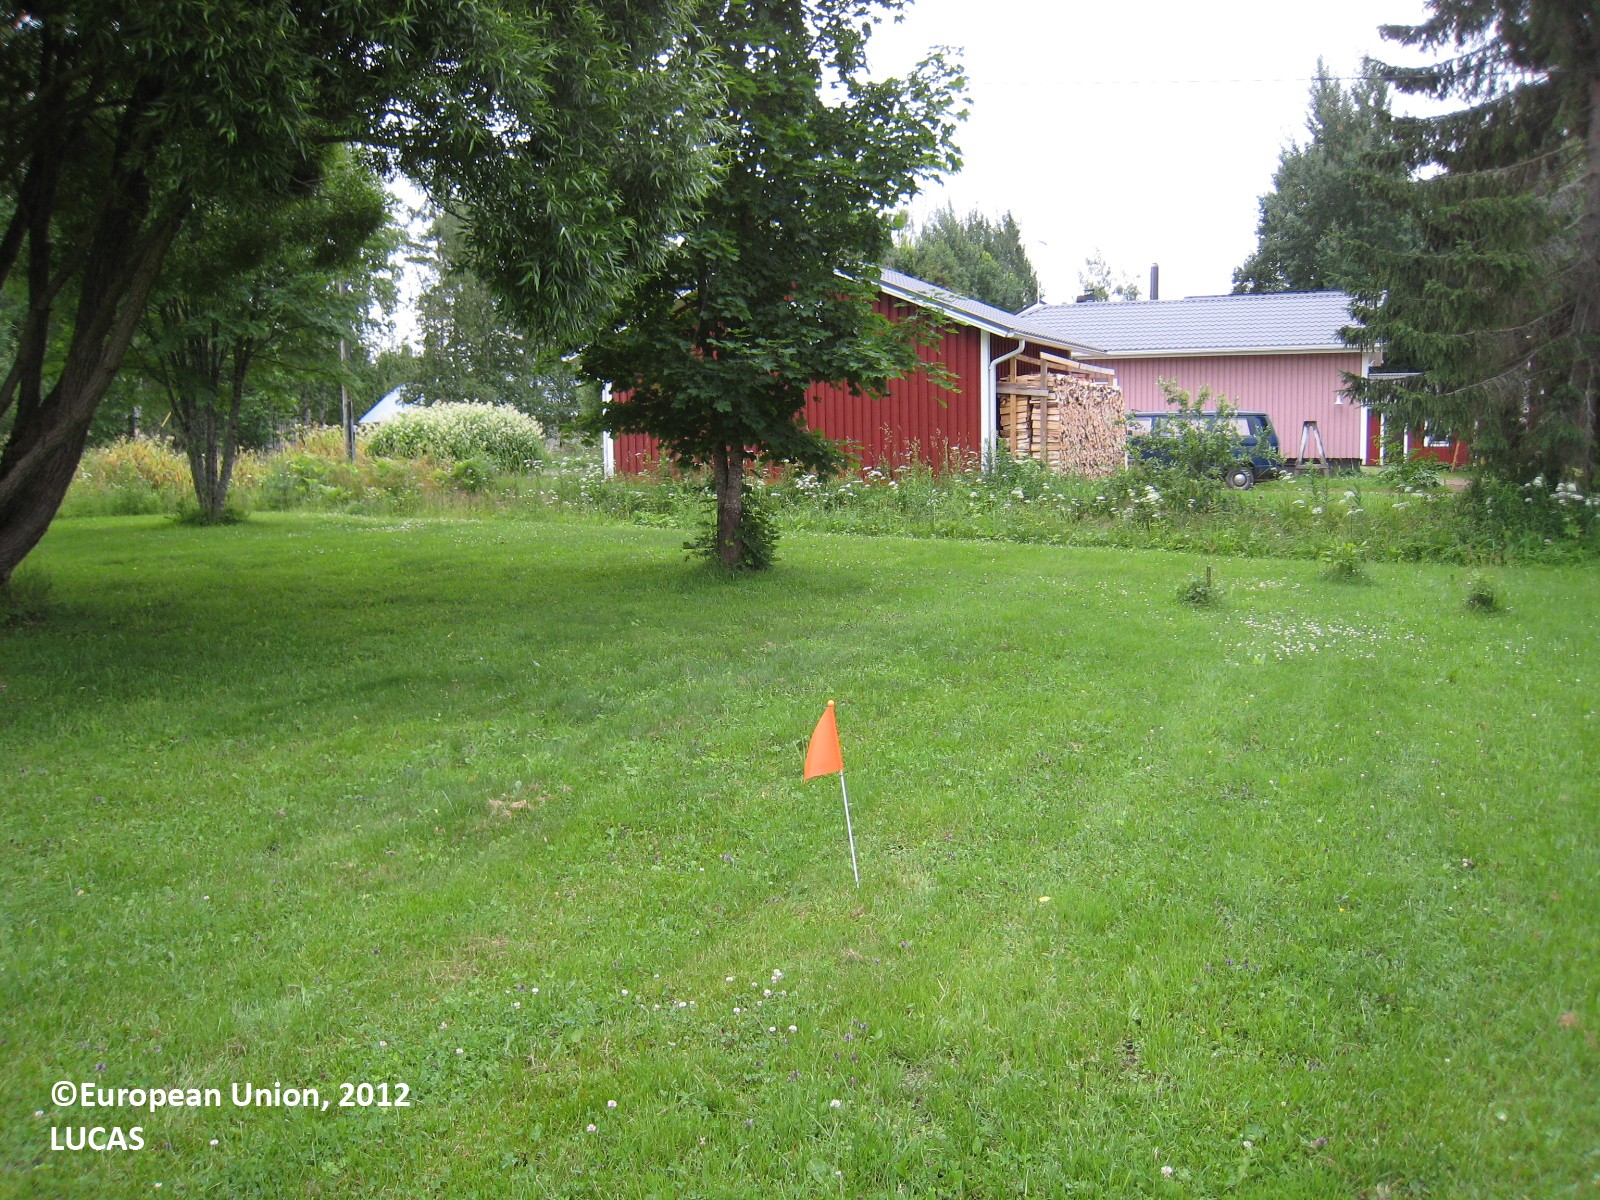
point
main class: Grassland
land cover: Grassland with sparse tree/shrub cover
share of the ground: > 75 %
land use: Residential
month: July
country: FI
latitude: 61.8284
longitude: 27.3922
